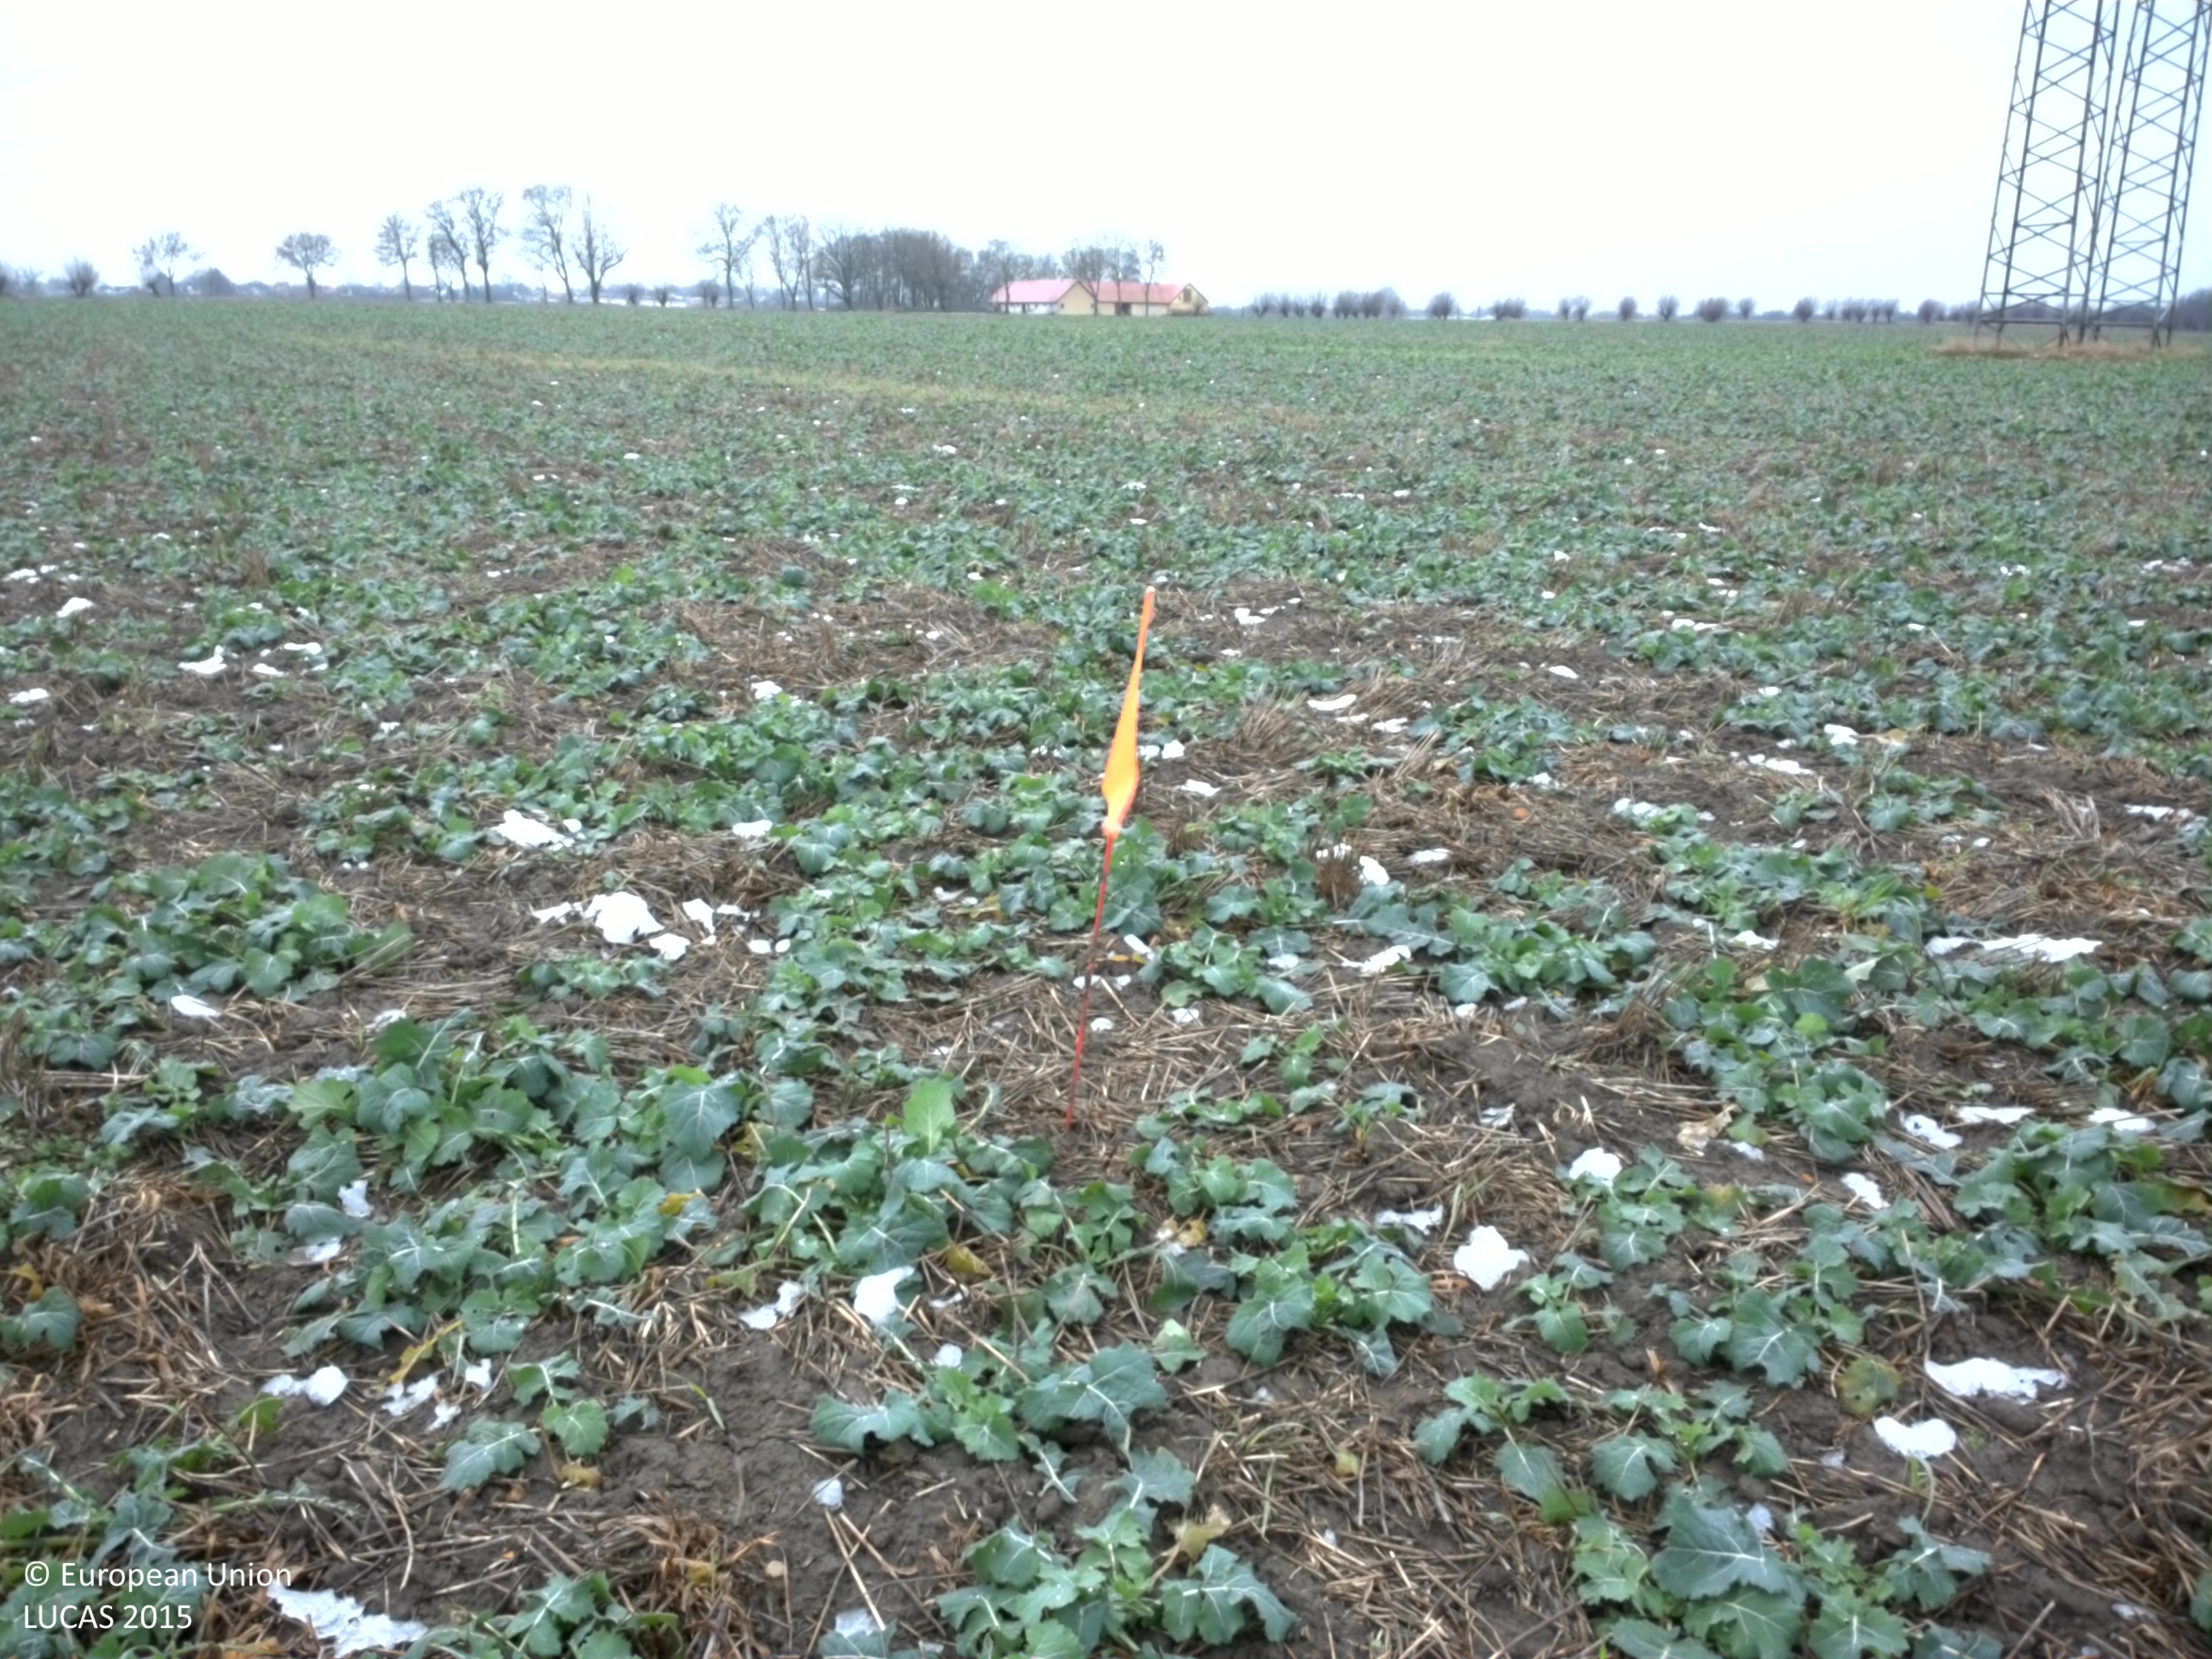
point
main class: Cropland
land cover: Rape and turnip rape
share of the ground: 25 - 50 %
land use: Agriculture (excluding fallow land and kitchen gardens)
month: November
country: SE
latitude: 55.6639
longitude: 13.1296
